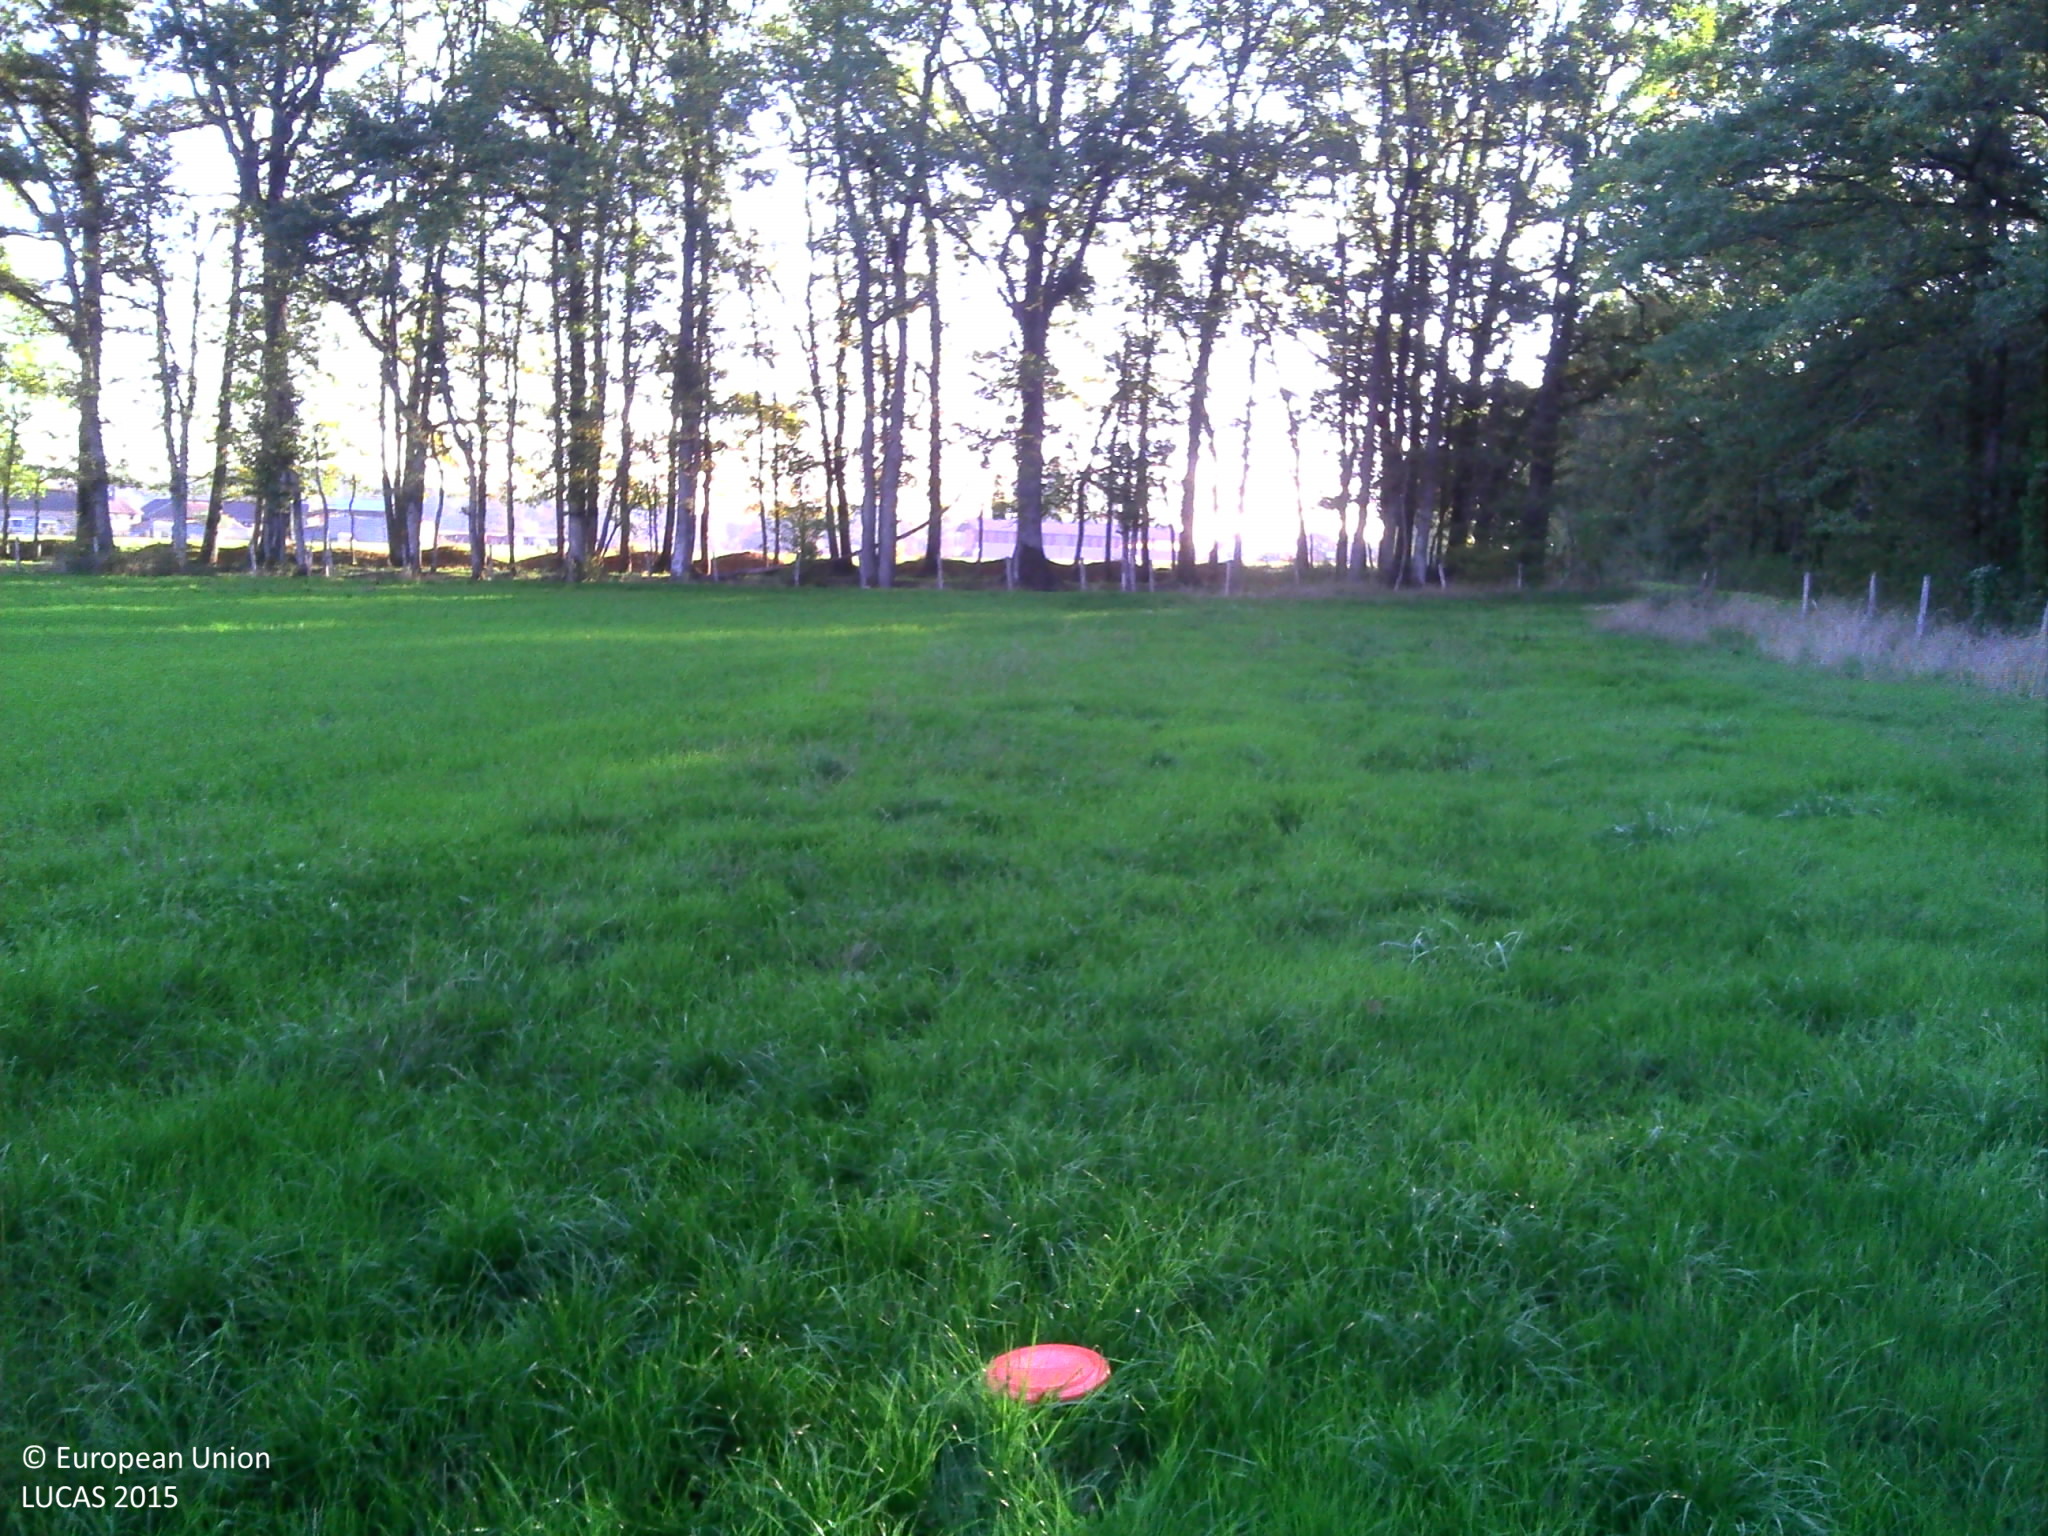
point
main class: Grassland
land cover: Grassland without tree/shrub cover
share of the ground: > 75 %
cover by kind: herbaceous plants 100 %
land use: Agriculture (excluding fallow land and kitchen gardens)
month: October
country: FR
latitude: 48.0362
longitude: 3.8938
